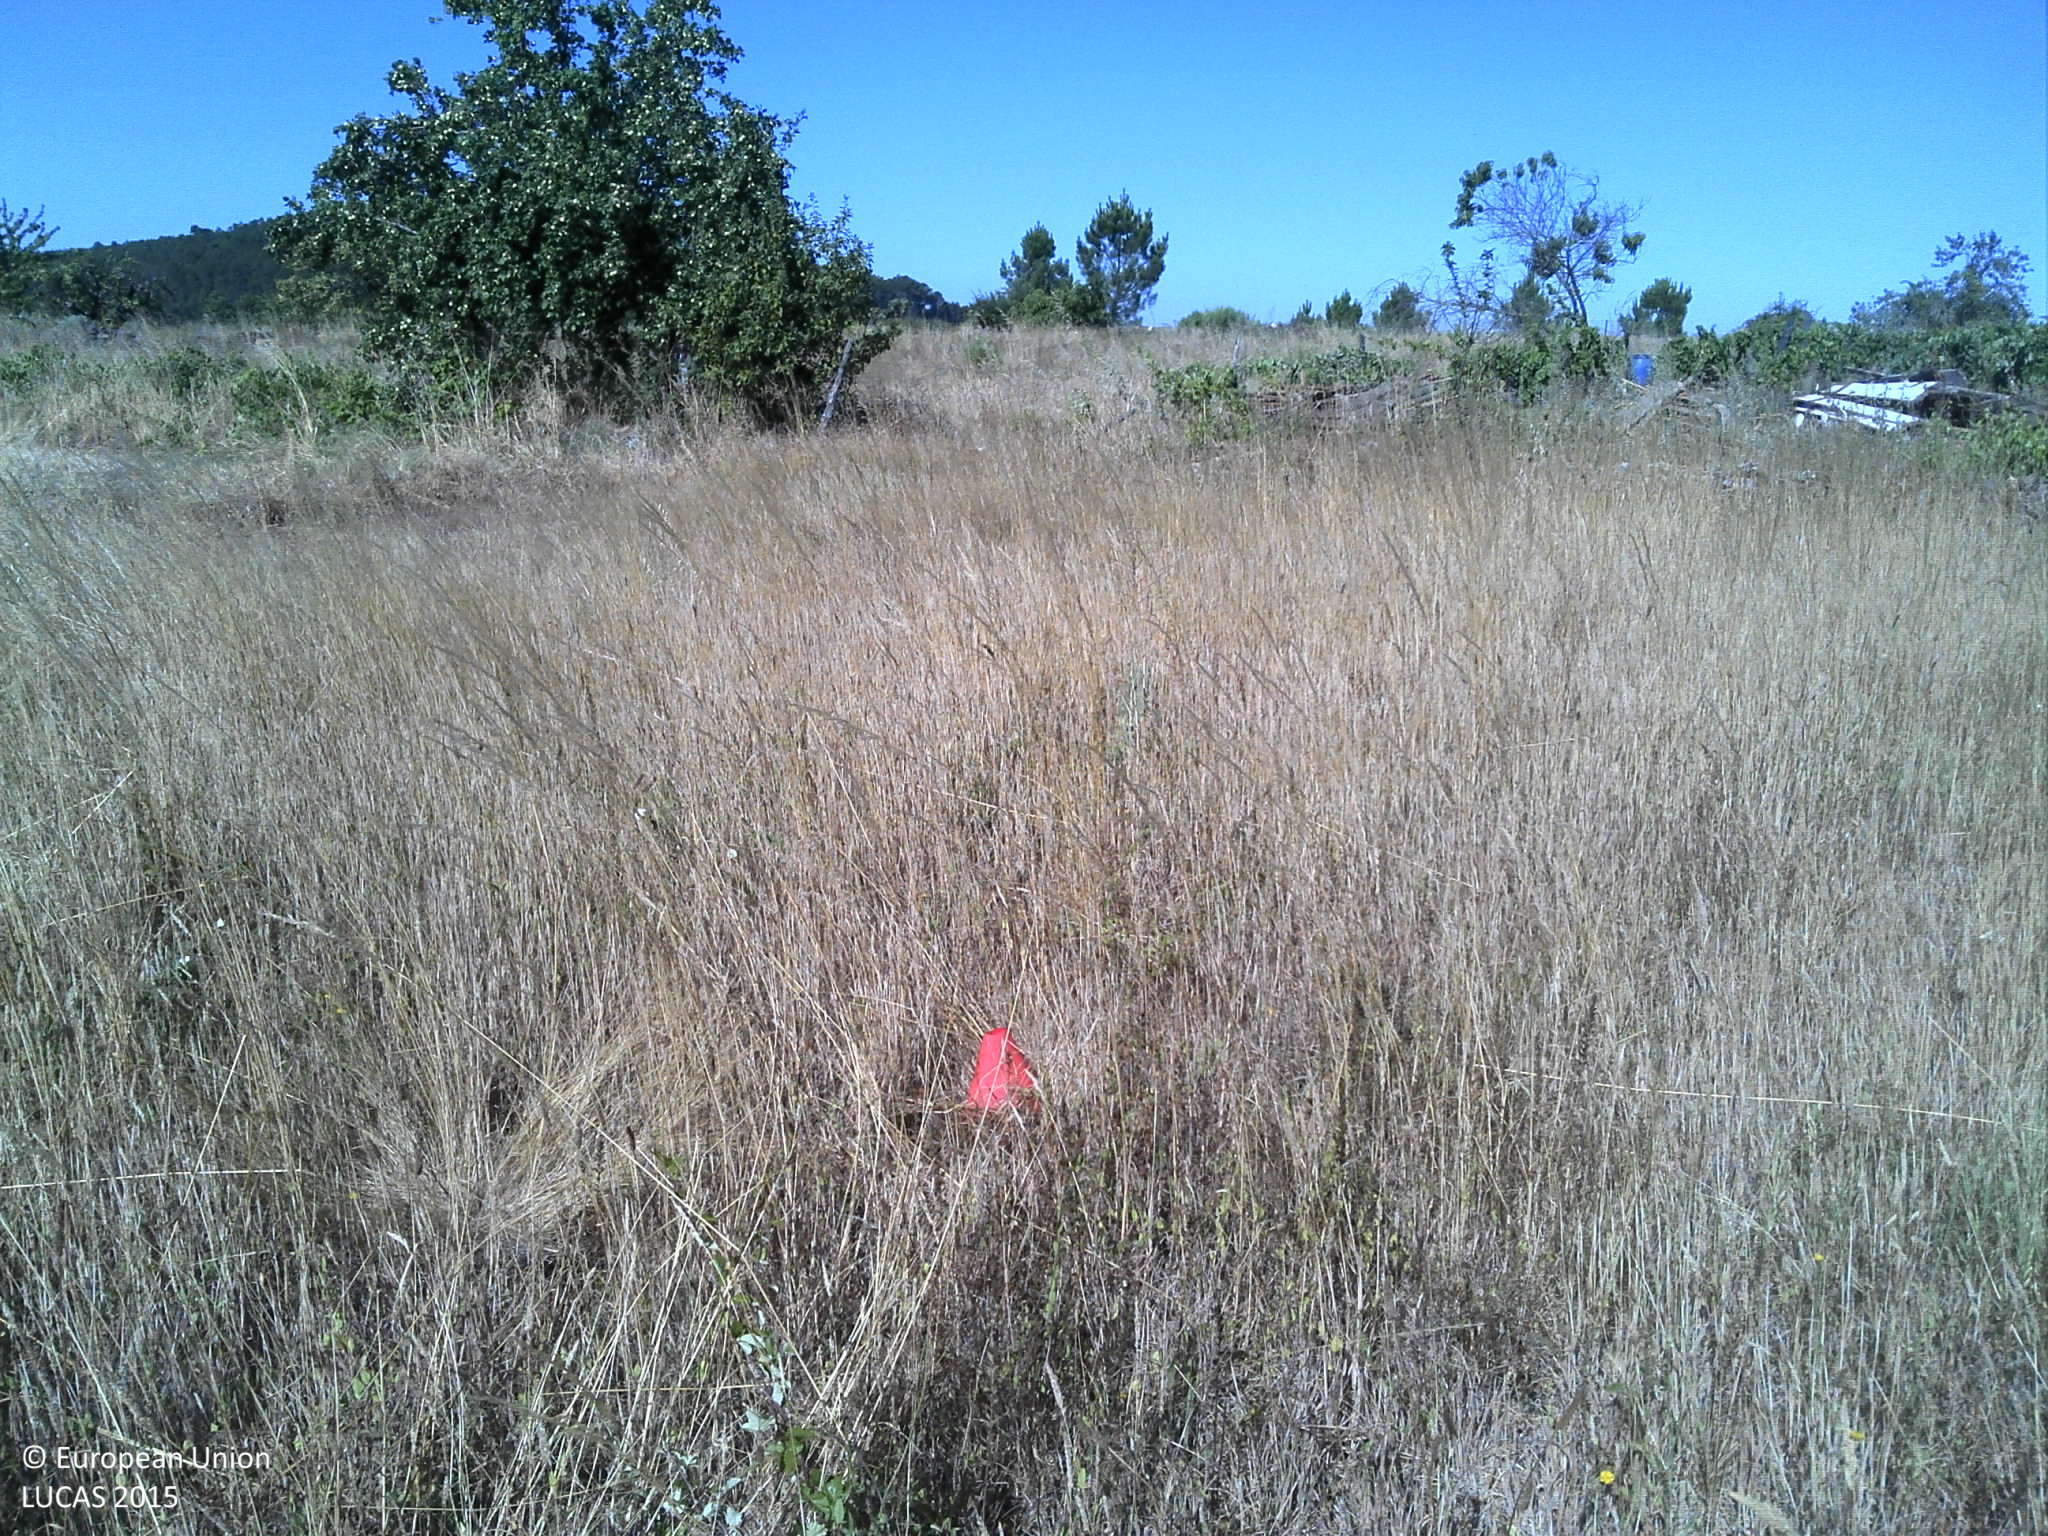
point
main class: Grassland
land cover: Grassland without tree/shrub cover
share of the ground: > 75 %
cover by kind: herbaceous plants 100 %
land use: Agriculture (excluding fallow land and kitchen gardens)
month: July
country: PT
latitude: 41.2336
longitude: -7.3593
